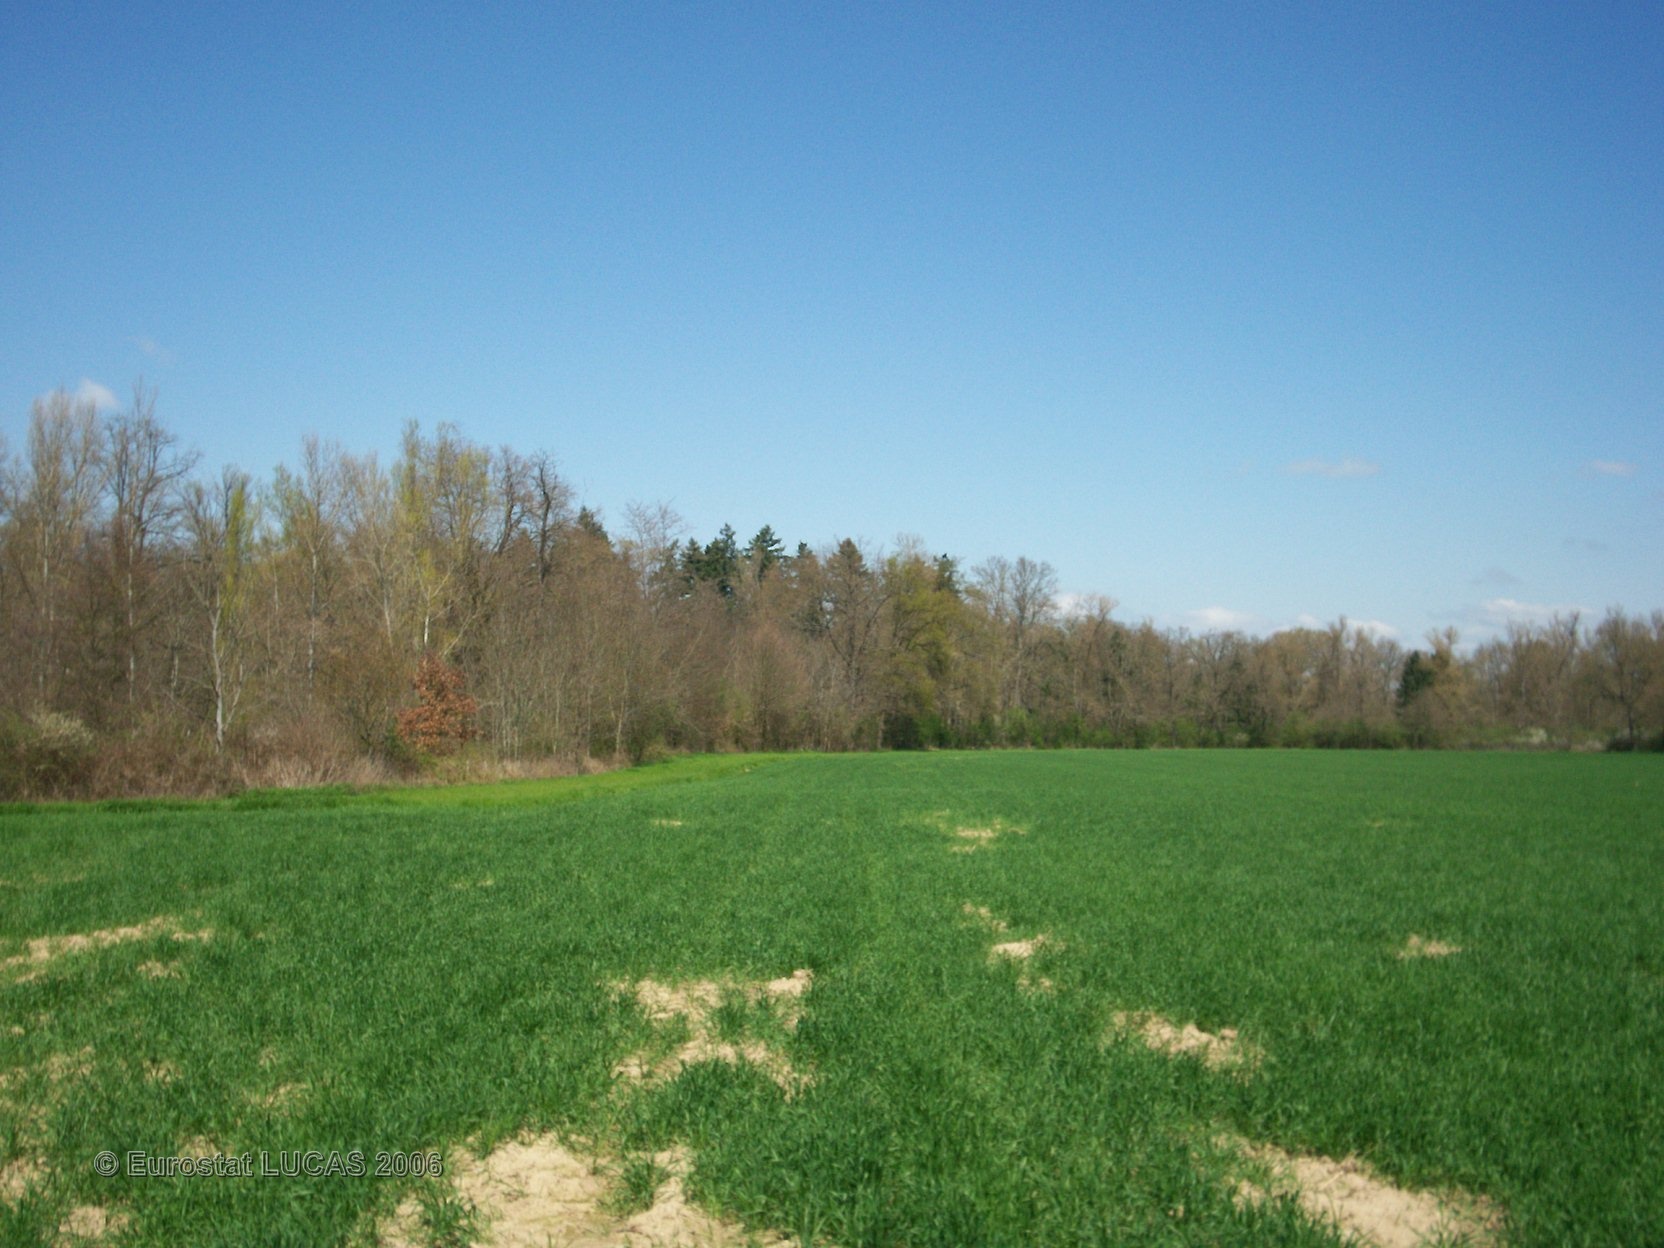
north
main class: Cropland
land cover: Common wheat
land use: Agriculture (excluding fallow land and kitchen gardens)
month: April
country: FR
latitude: 45.7413
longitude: 4.1804
